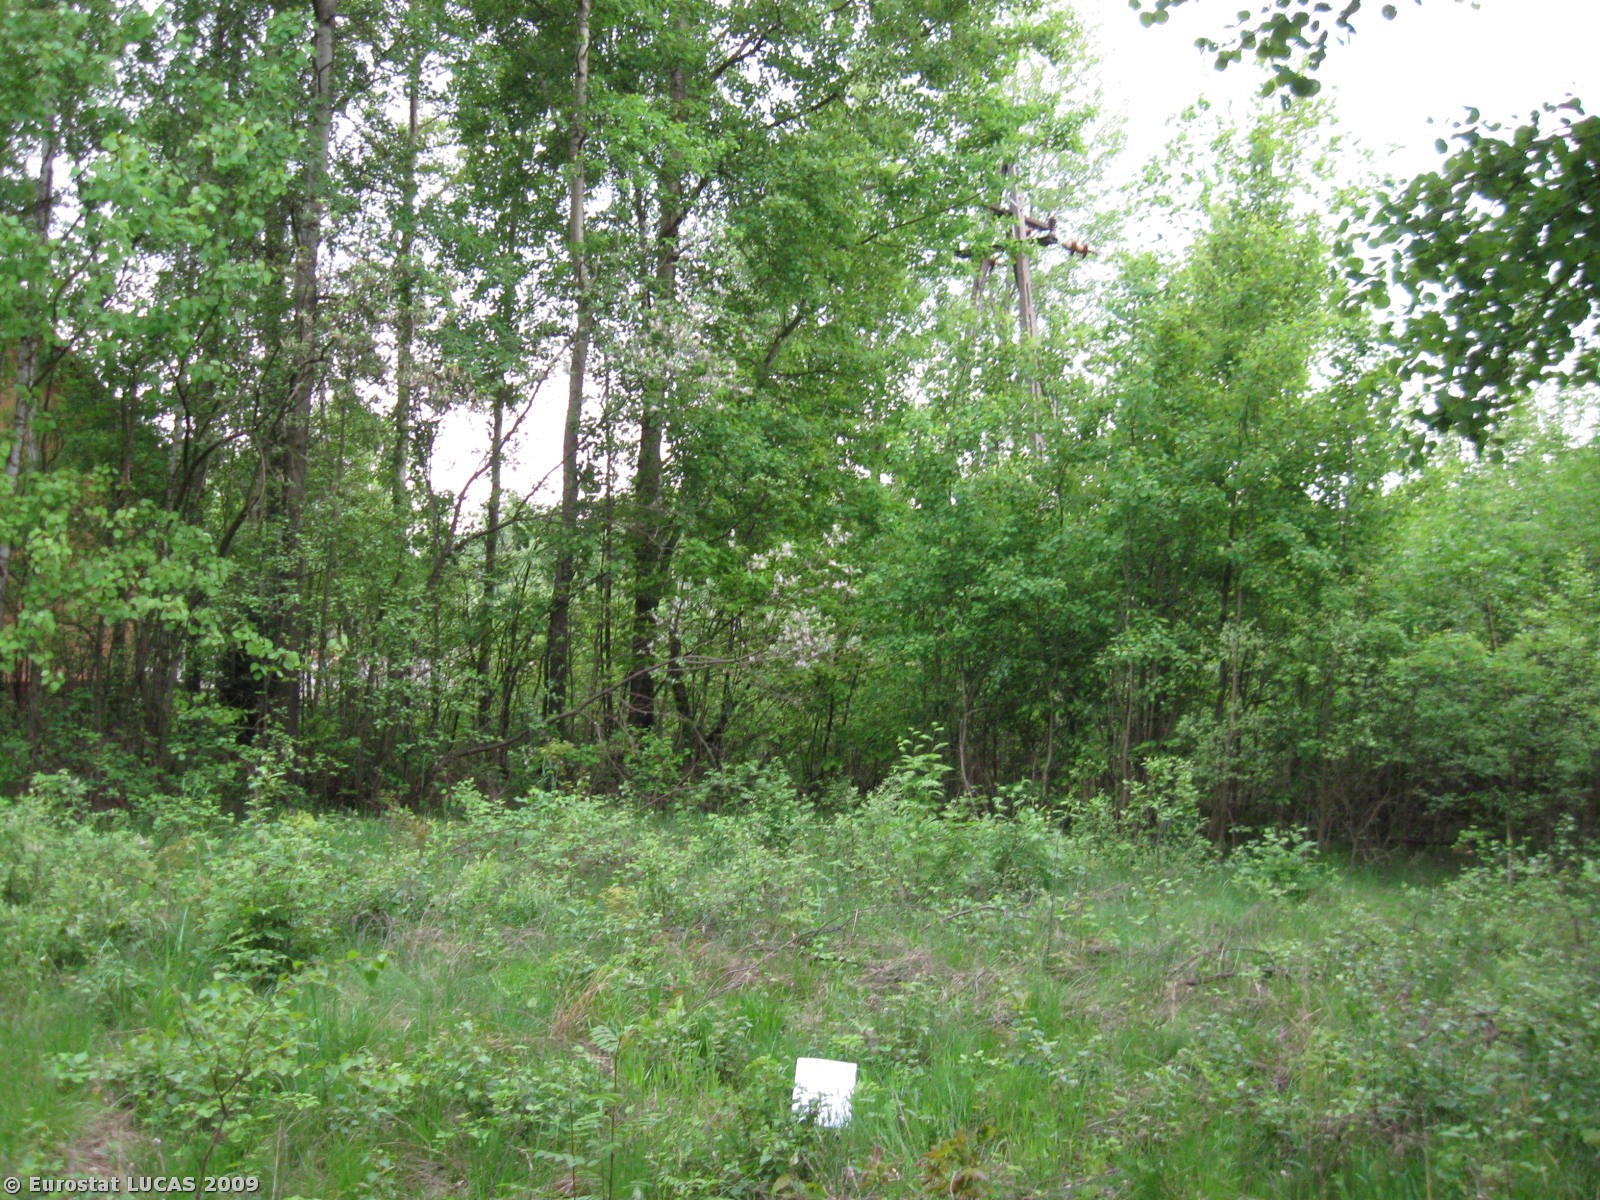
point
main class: Woodland
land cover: Broadleaved woodland
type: hemiboreal forest and nemoral coniferous forest and mixed broadleaved-coniferous forest
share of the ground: > 75 %
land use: Forestry
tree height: > 5 m
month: May
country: PL
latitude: 51.0052
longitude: 20.4843
